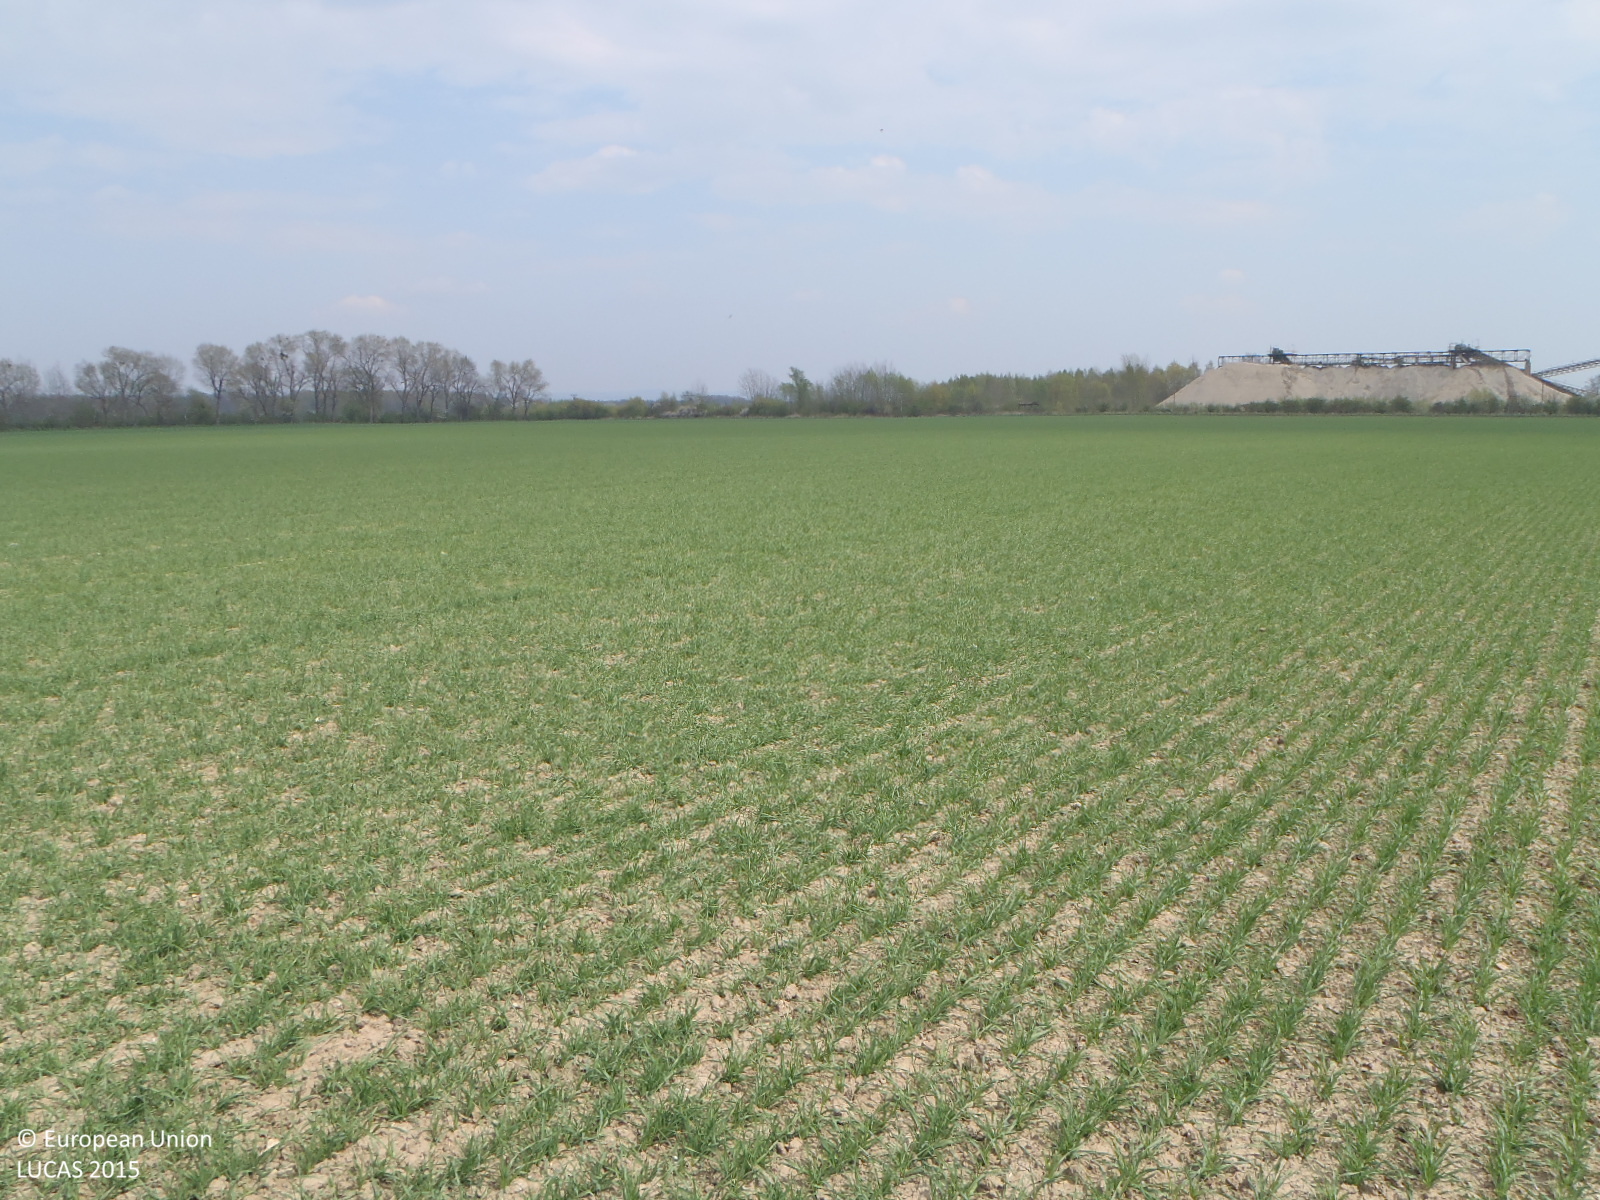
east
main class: Cropland
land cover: Barley
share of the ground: 50 - 75 %
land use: Agriculture (excluding fallow land and kitchen gardens)
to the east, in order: Barley
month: April
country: CZ
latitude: 49.6728
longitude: 17.1188
